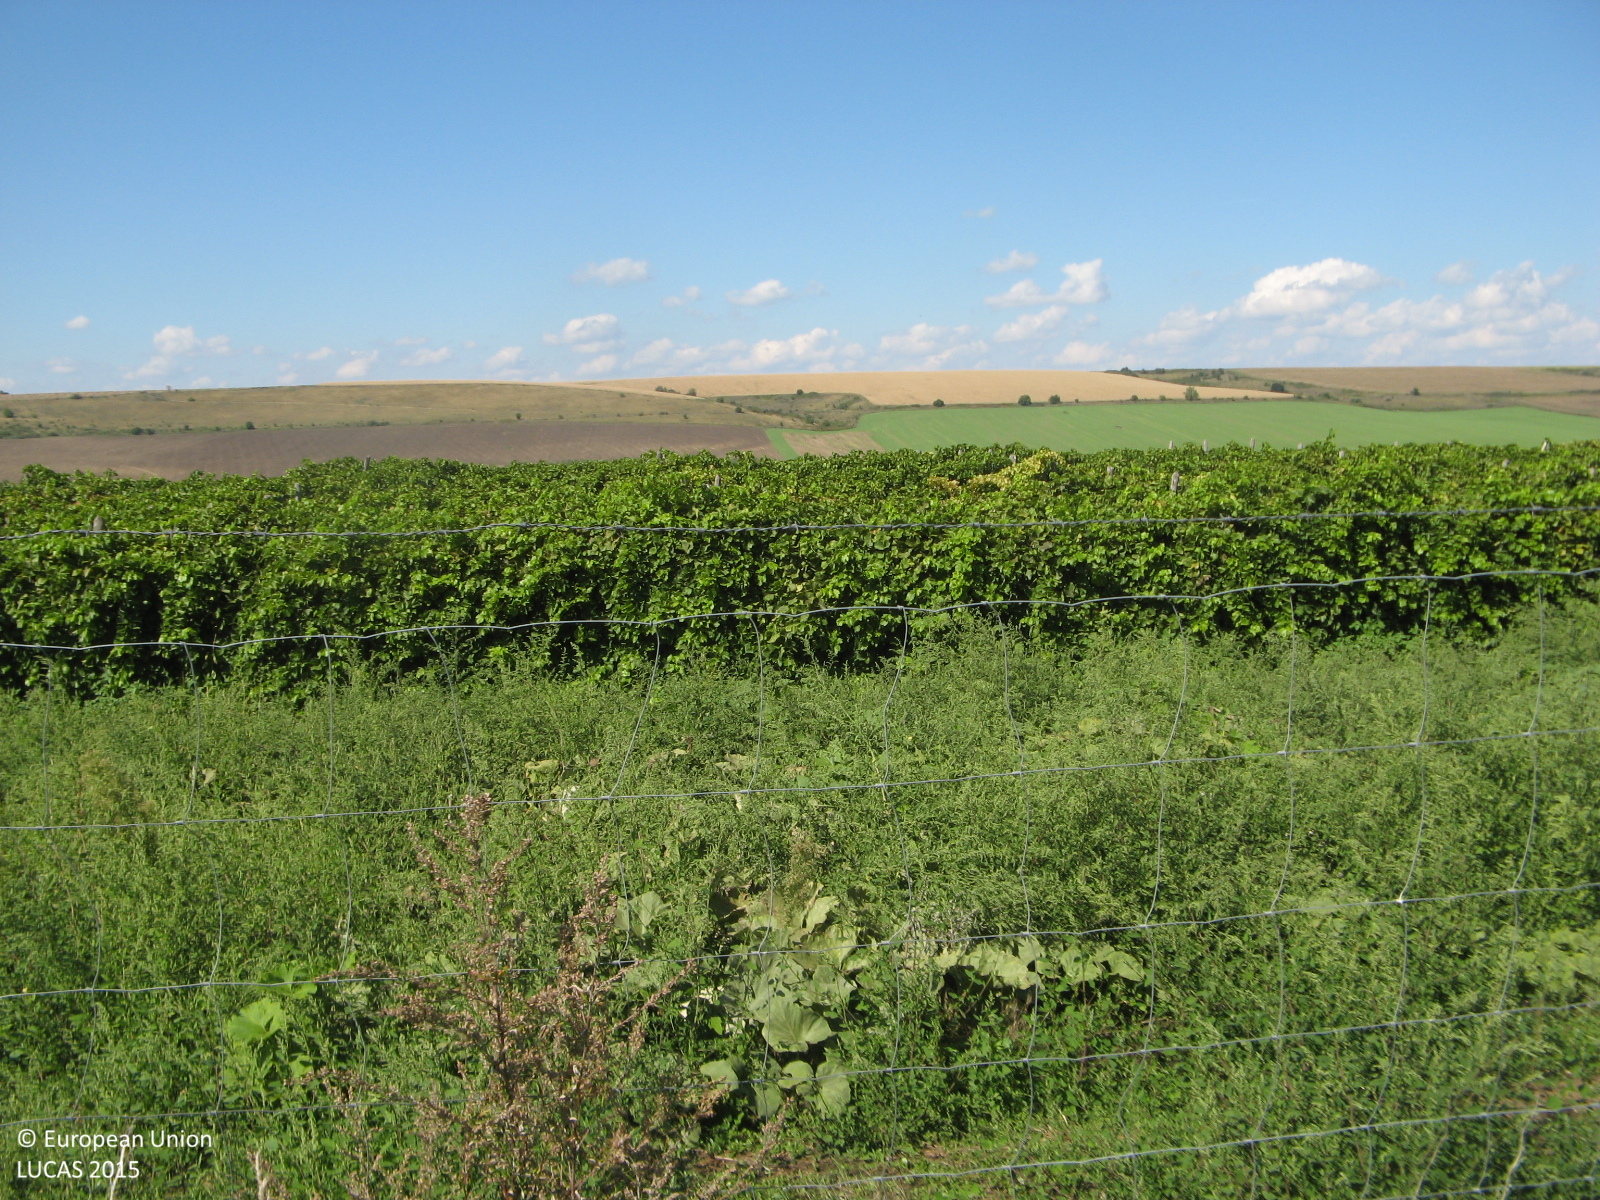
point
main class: Cropland
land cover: Vineyards
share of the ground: > 75 %
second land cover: Spontaneously vegetated surfaces
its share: 10 - 25 %
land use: Agriculture (excluding fallow land and kitchen gardens)
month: September
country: BG
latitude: 43.5743
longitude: 25.4229
